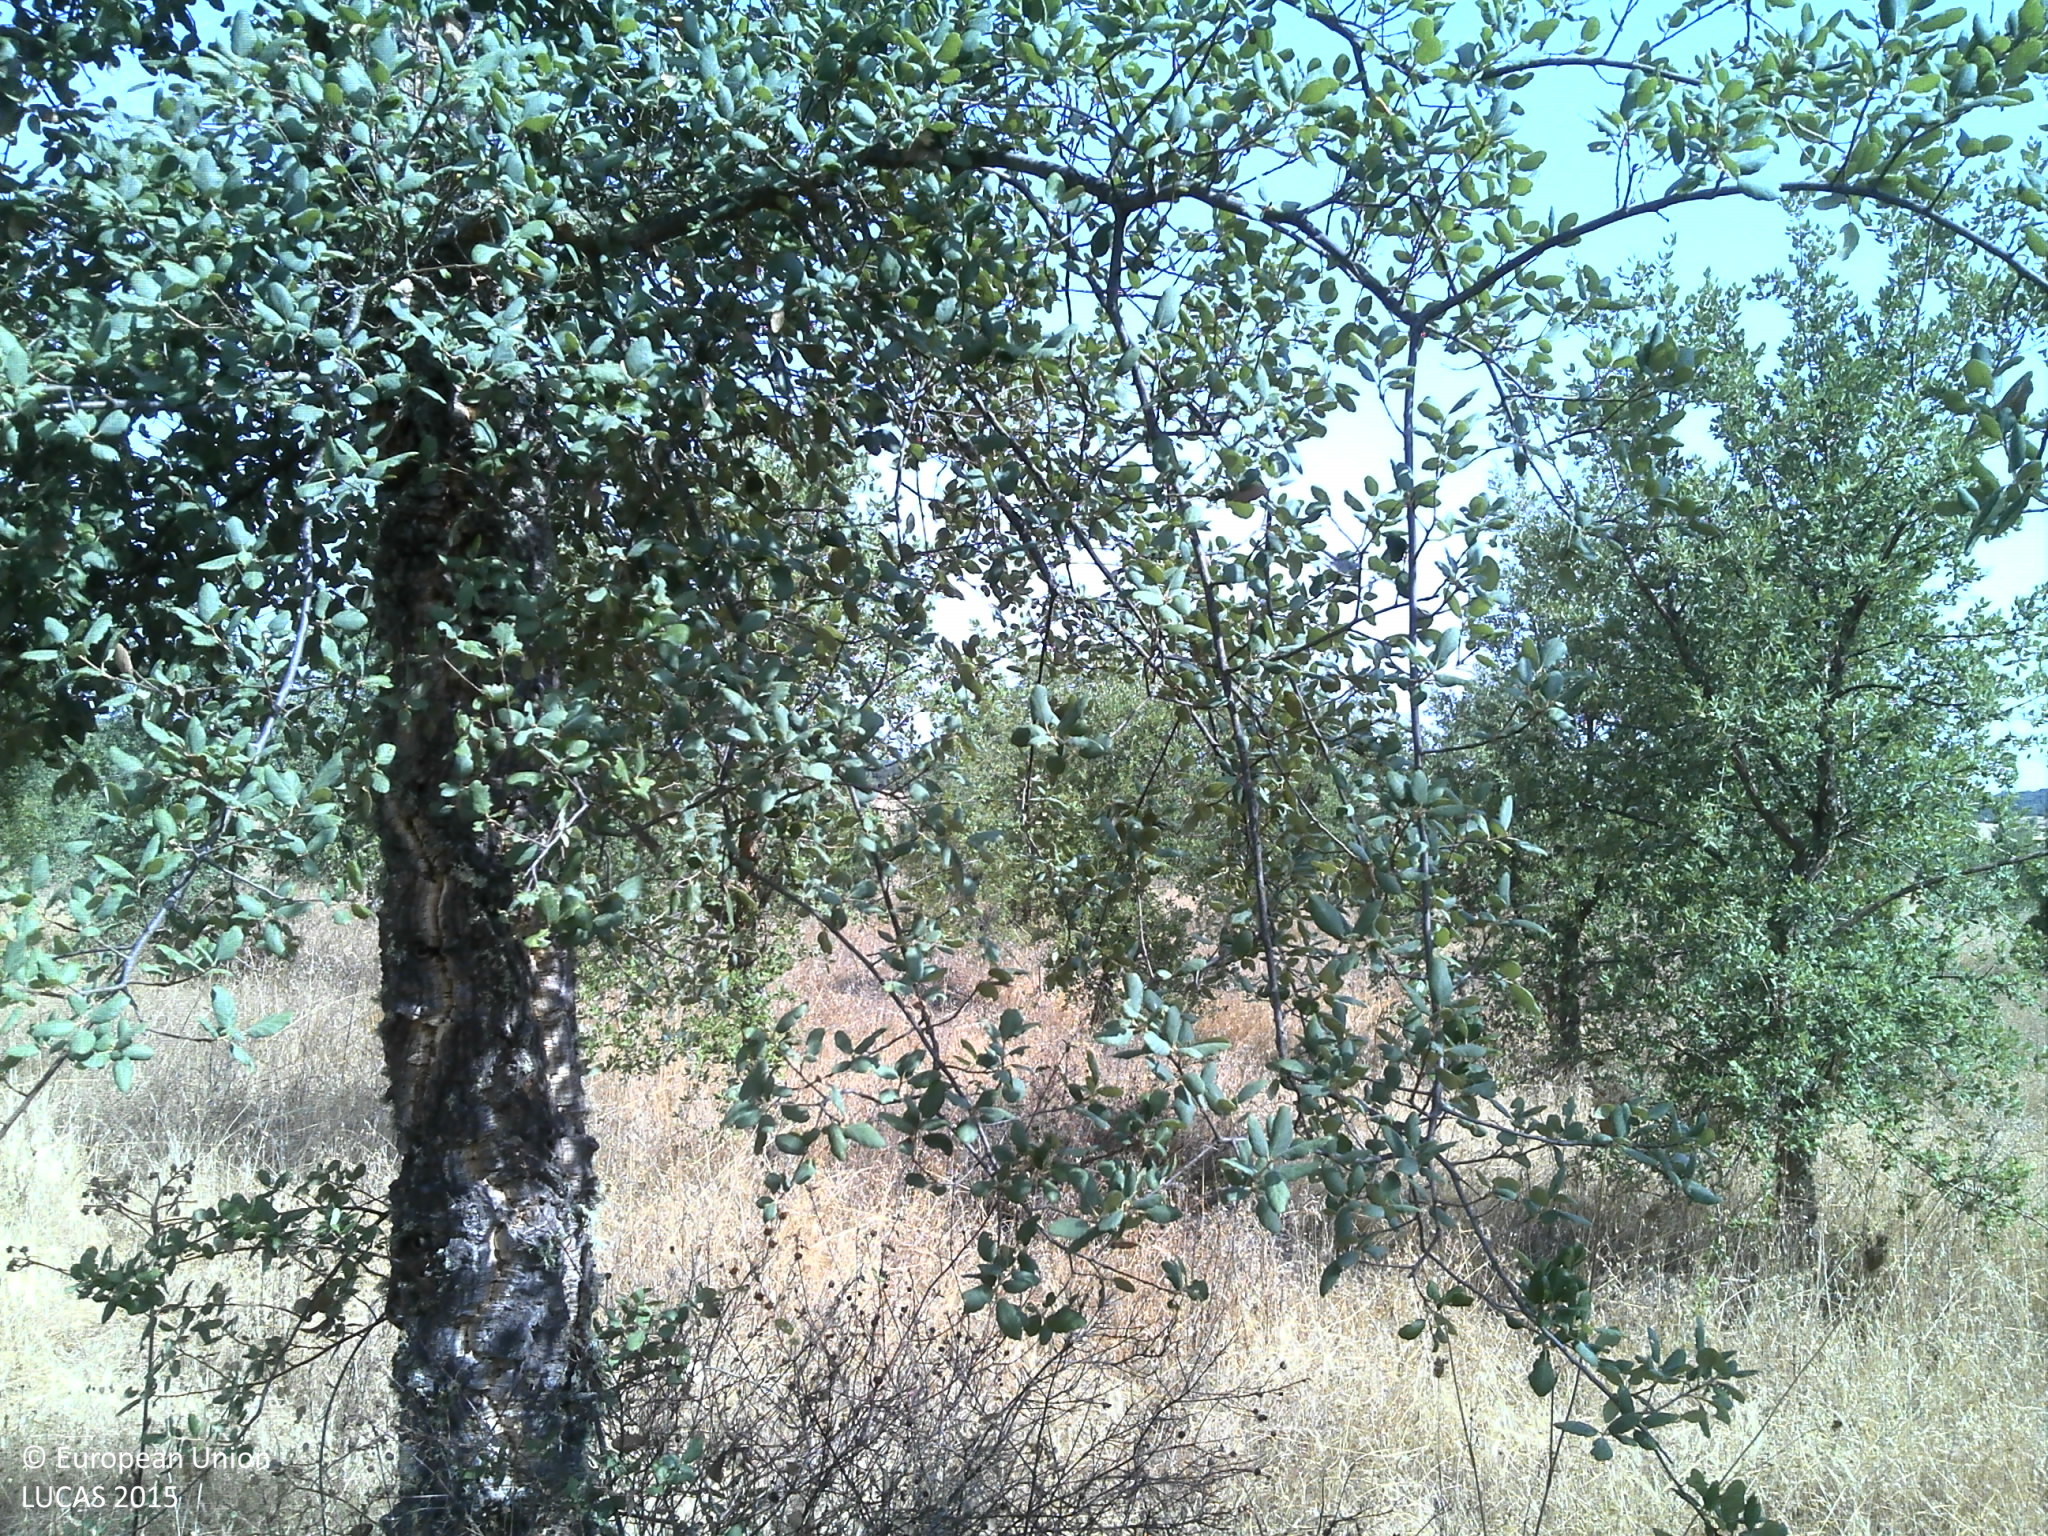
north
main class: Woodland
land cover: Broadleaved woodland
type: broadleaved evergreen forest
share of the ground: 10 - 25 %
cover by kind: herbaceous plants 50 %, unconsolidated bare surface 35 %, broadleaved forest trees 15 %
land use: Forestry
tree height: < 5 m
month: August
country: PT
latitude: 39.2830
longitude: -7.5376
